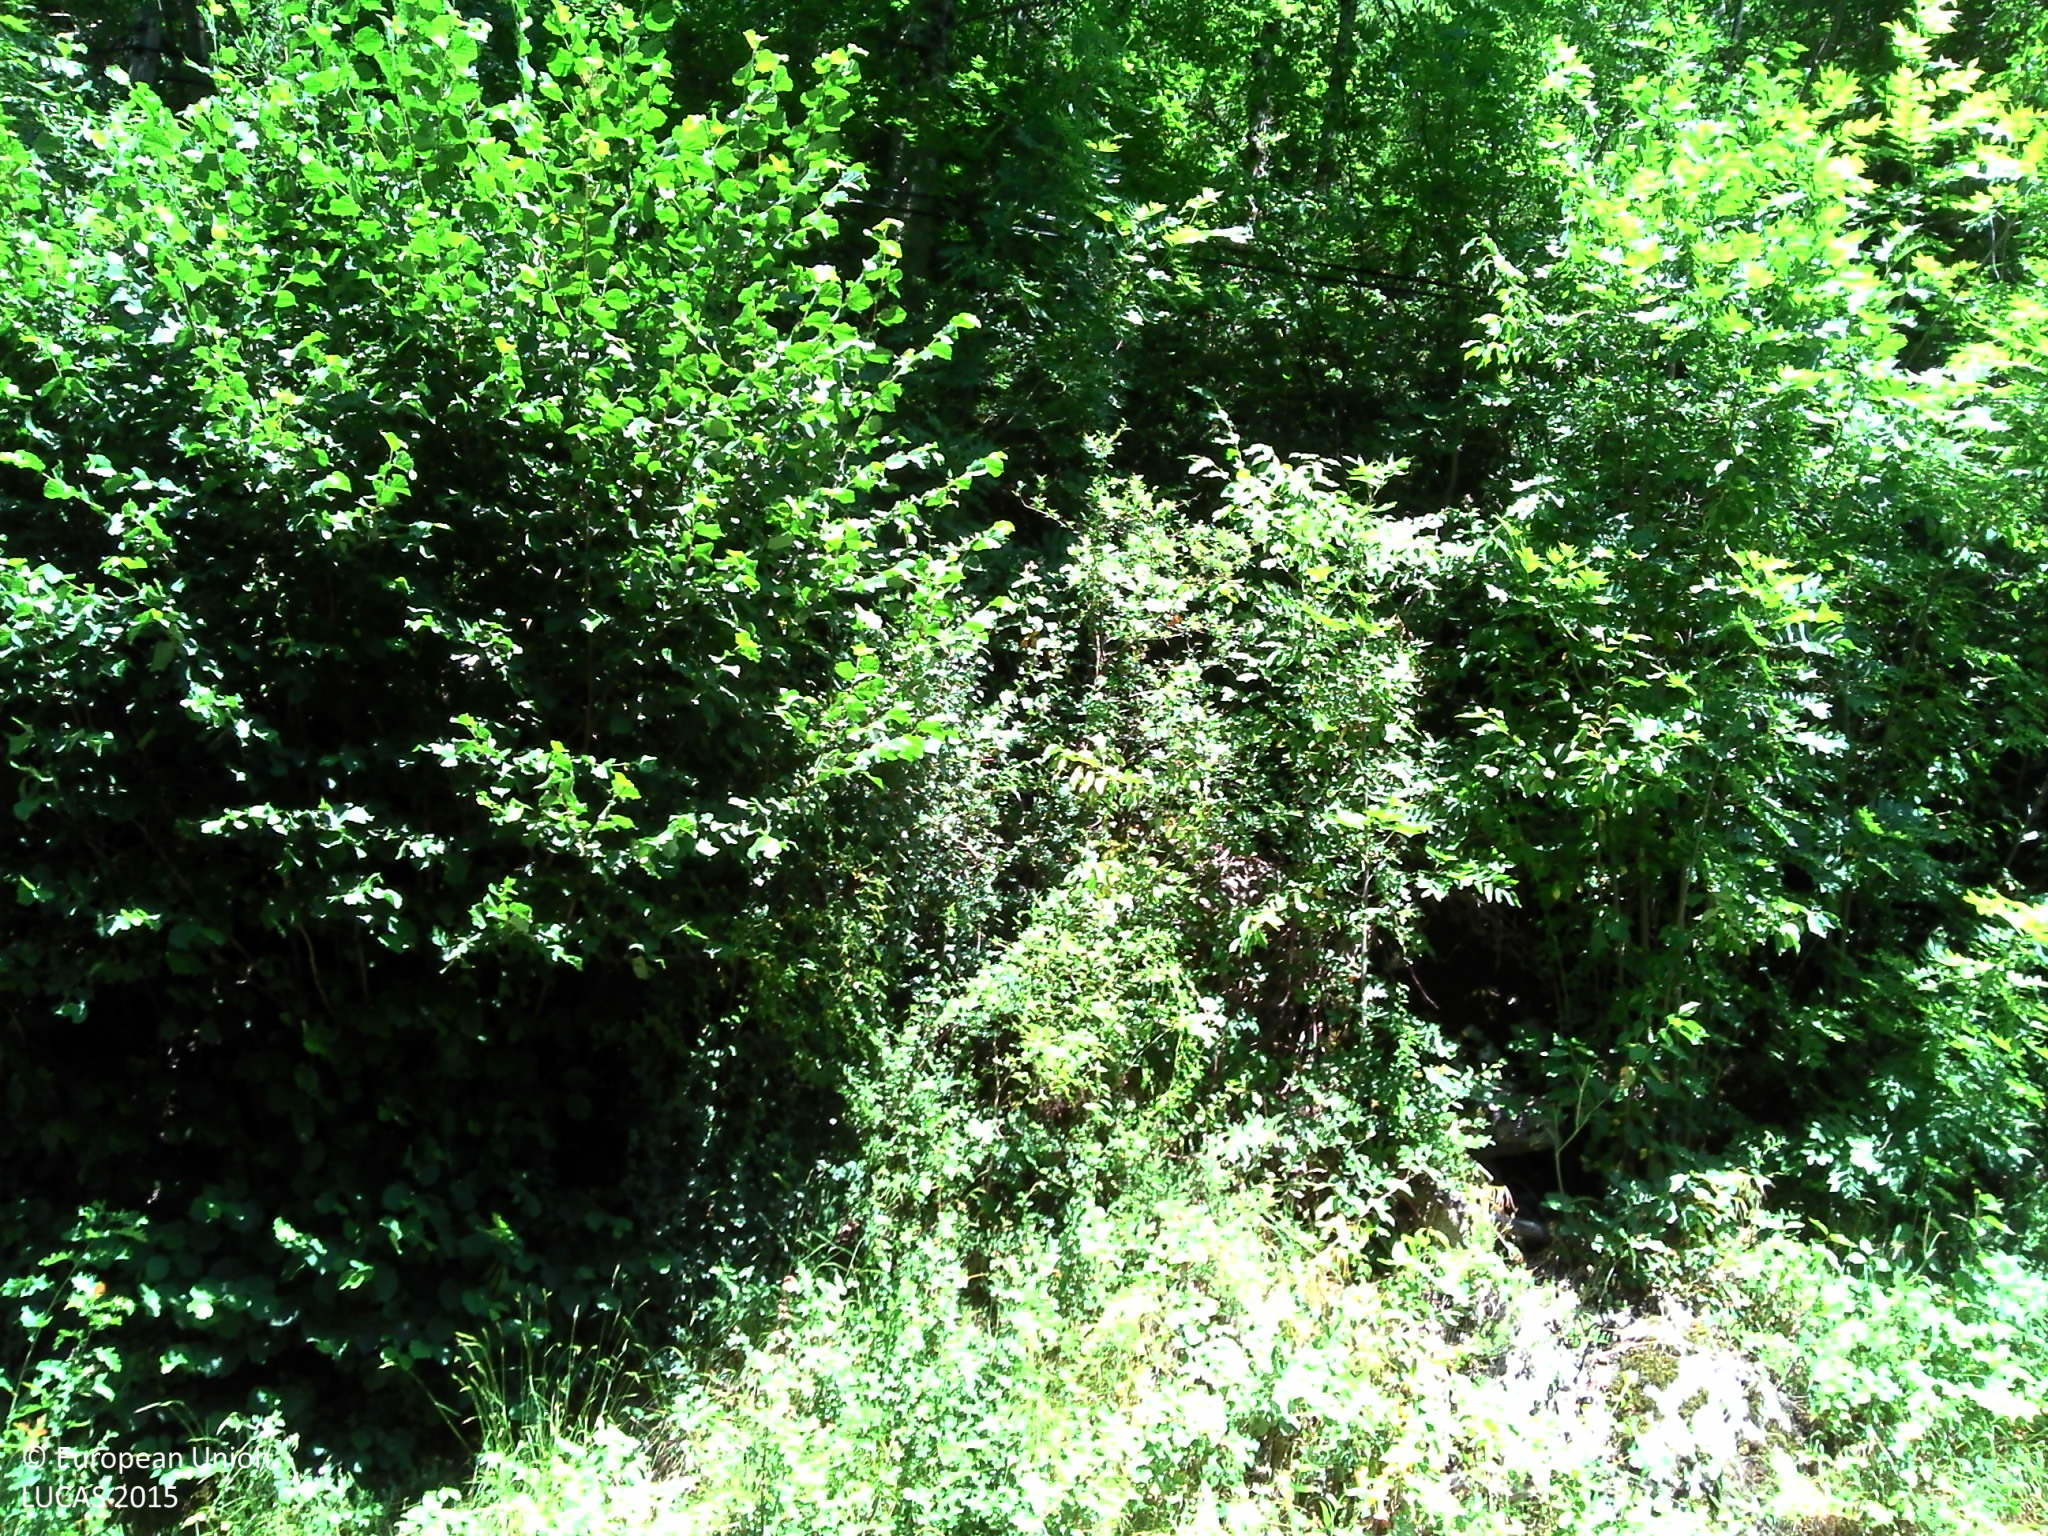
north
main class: Woodland
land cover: Broadleaved woodland
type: mesophytic deciduous forest
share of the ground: > 75 %
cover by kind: broadleaved forest trees 90 %, herbaceous plants 10 %
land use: Semi-natural and natural areas not in use
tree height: > 5 m
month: July
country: FR
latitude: 42.7266
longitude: 2.1083
